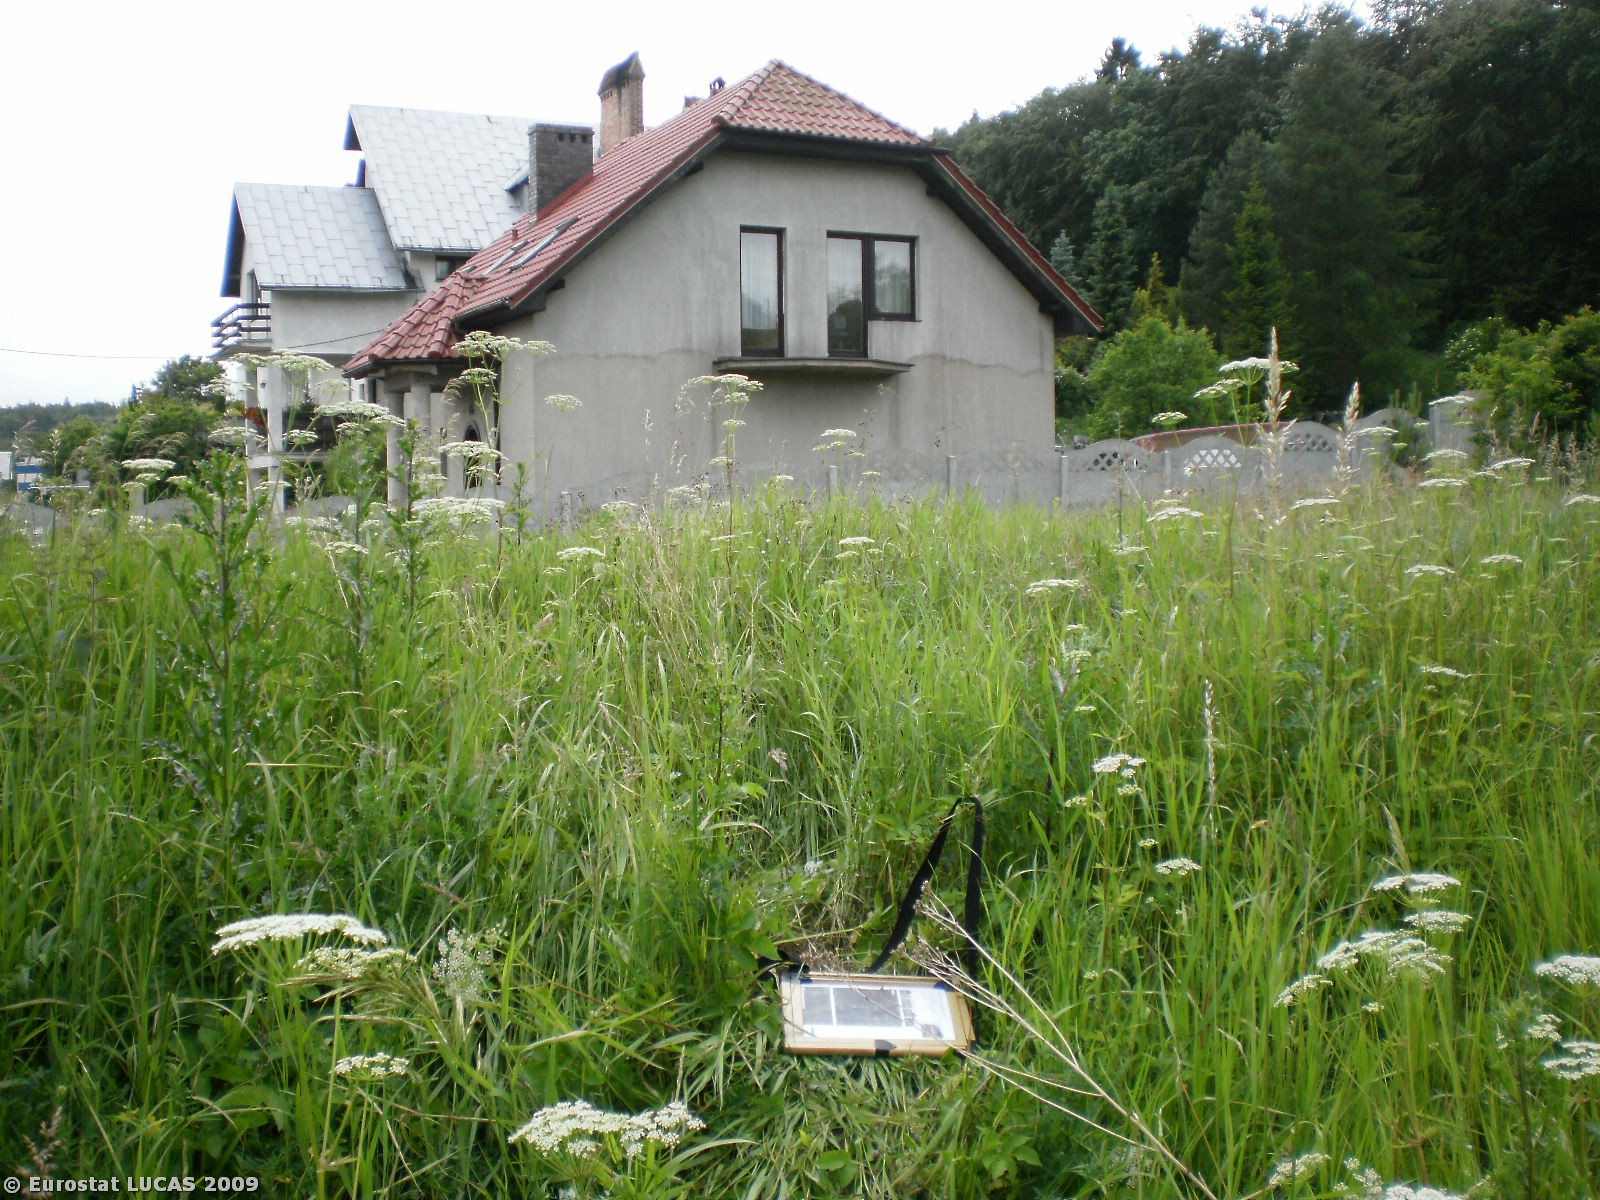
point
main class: Grassland
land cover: Grassland with sparse tree/shrub cover
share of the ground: > 75 %
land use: Unused
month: June
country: PL
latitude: 54.4597
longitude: 18.4858
